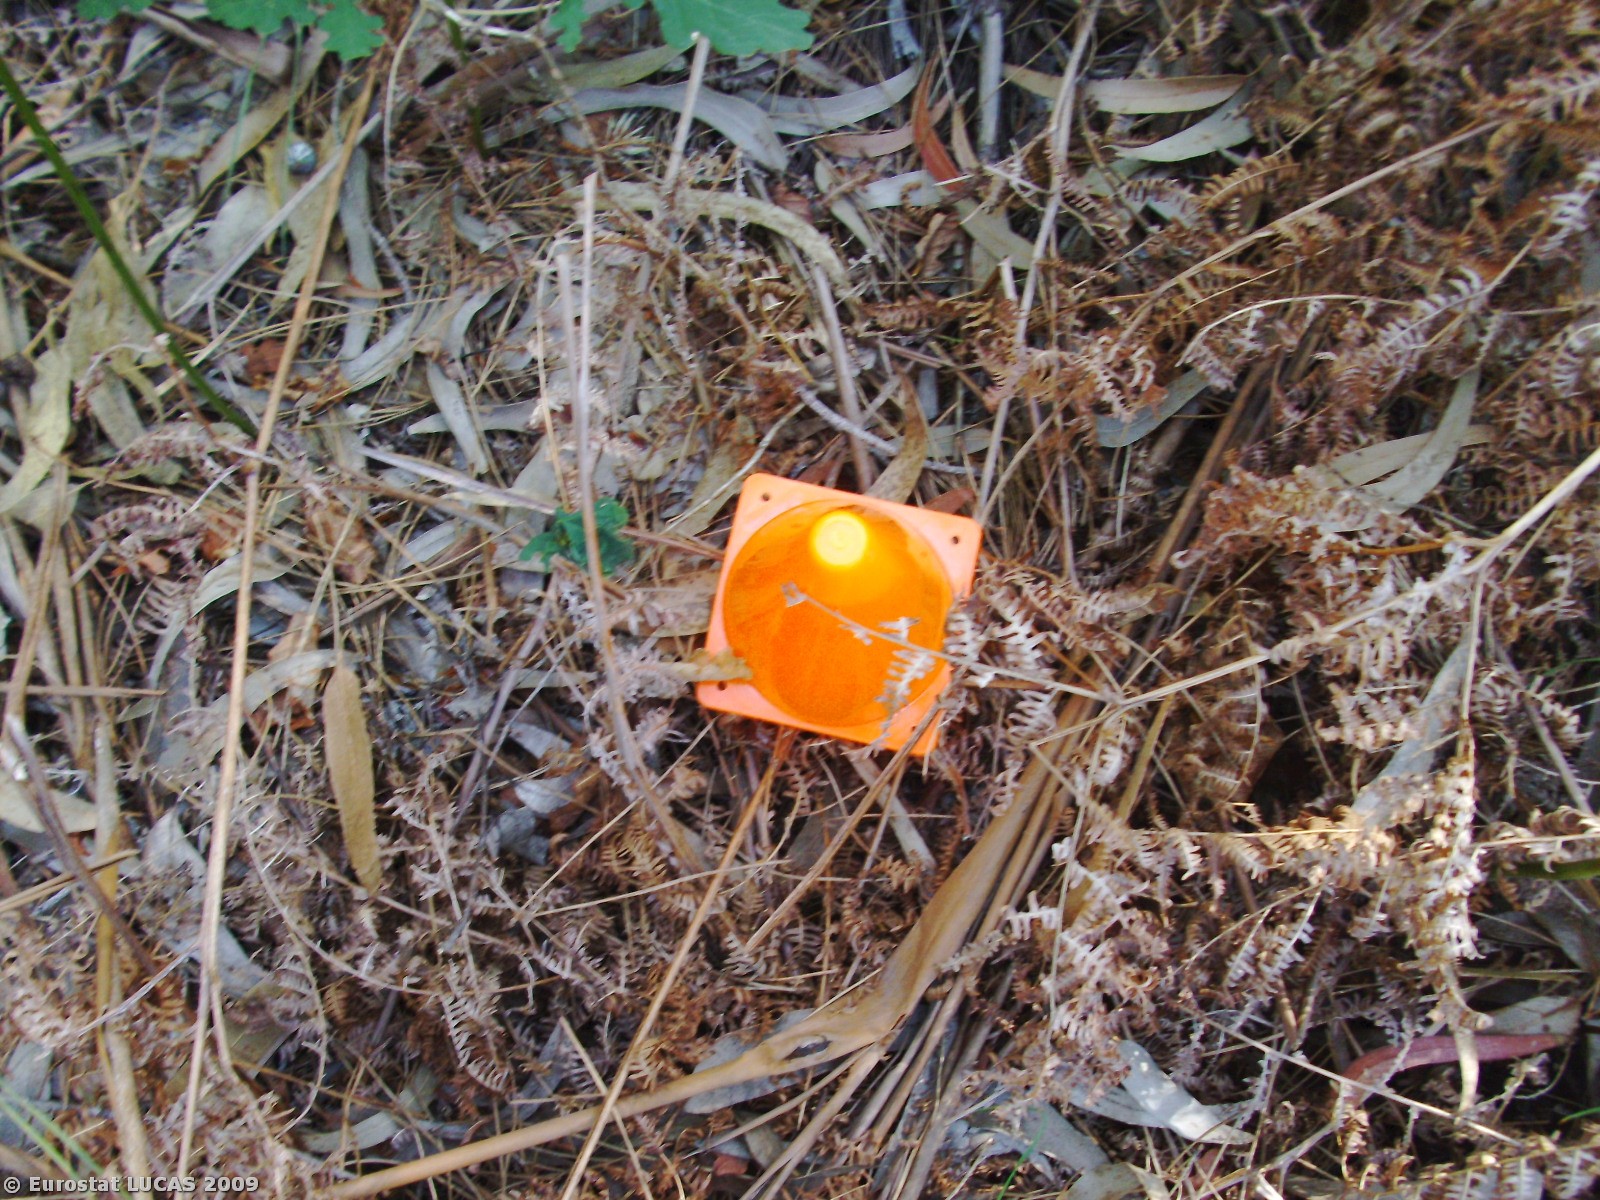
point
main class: Woodland
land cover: Broadleaved woodland
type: plantations and self-sown exotic forest
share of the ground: > 75 %
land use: Forestry
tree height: > 5 m
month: May
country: PT
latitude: 40.6708
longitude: -8.4156
